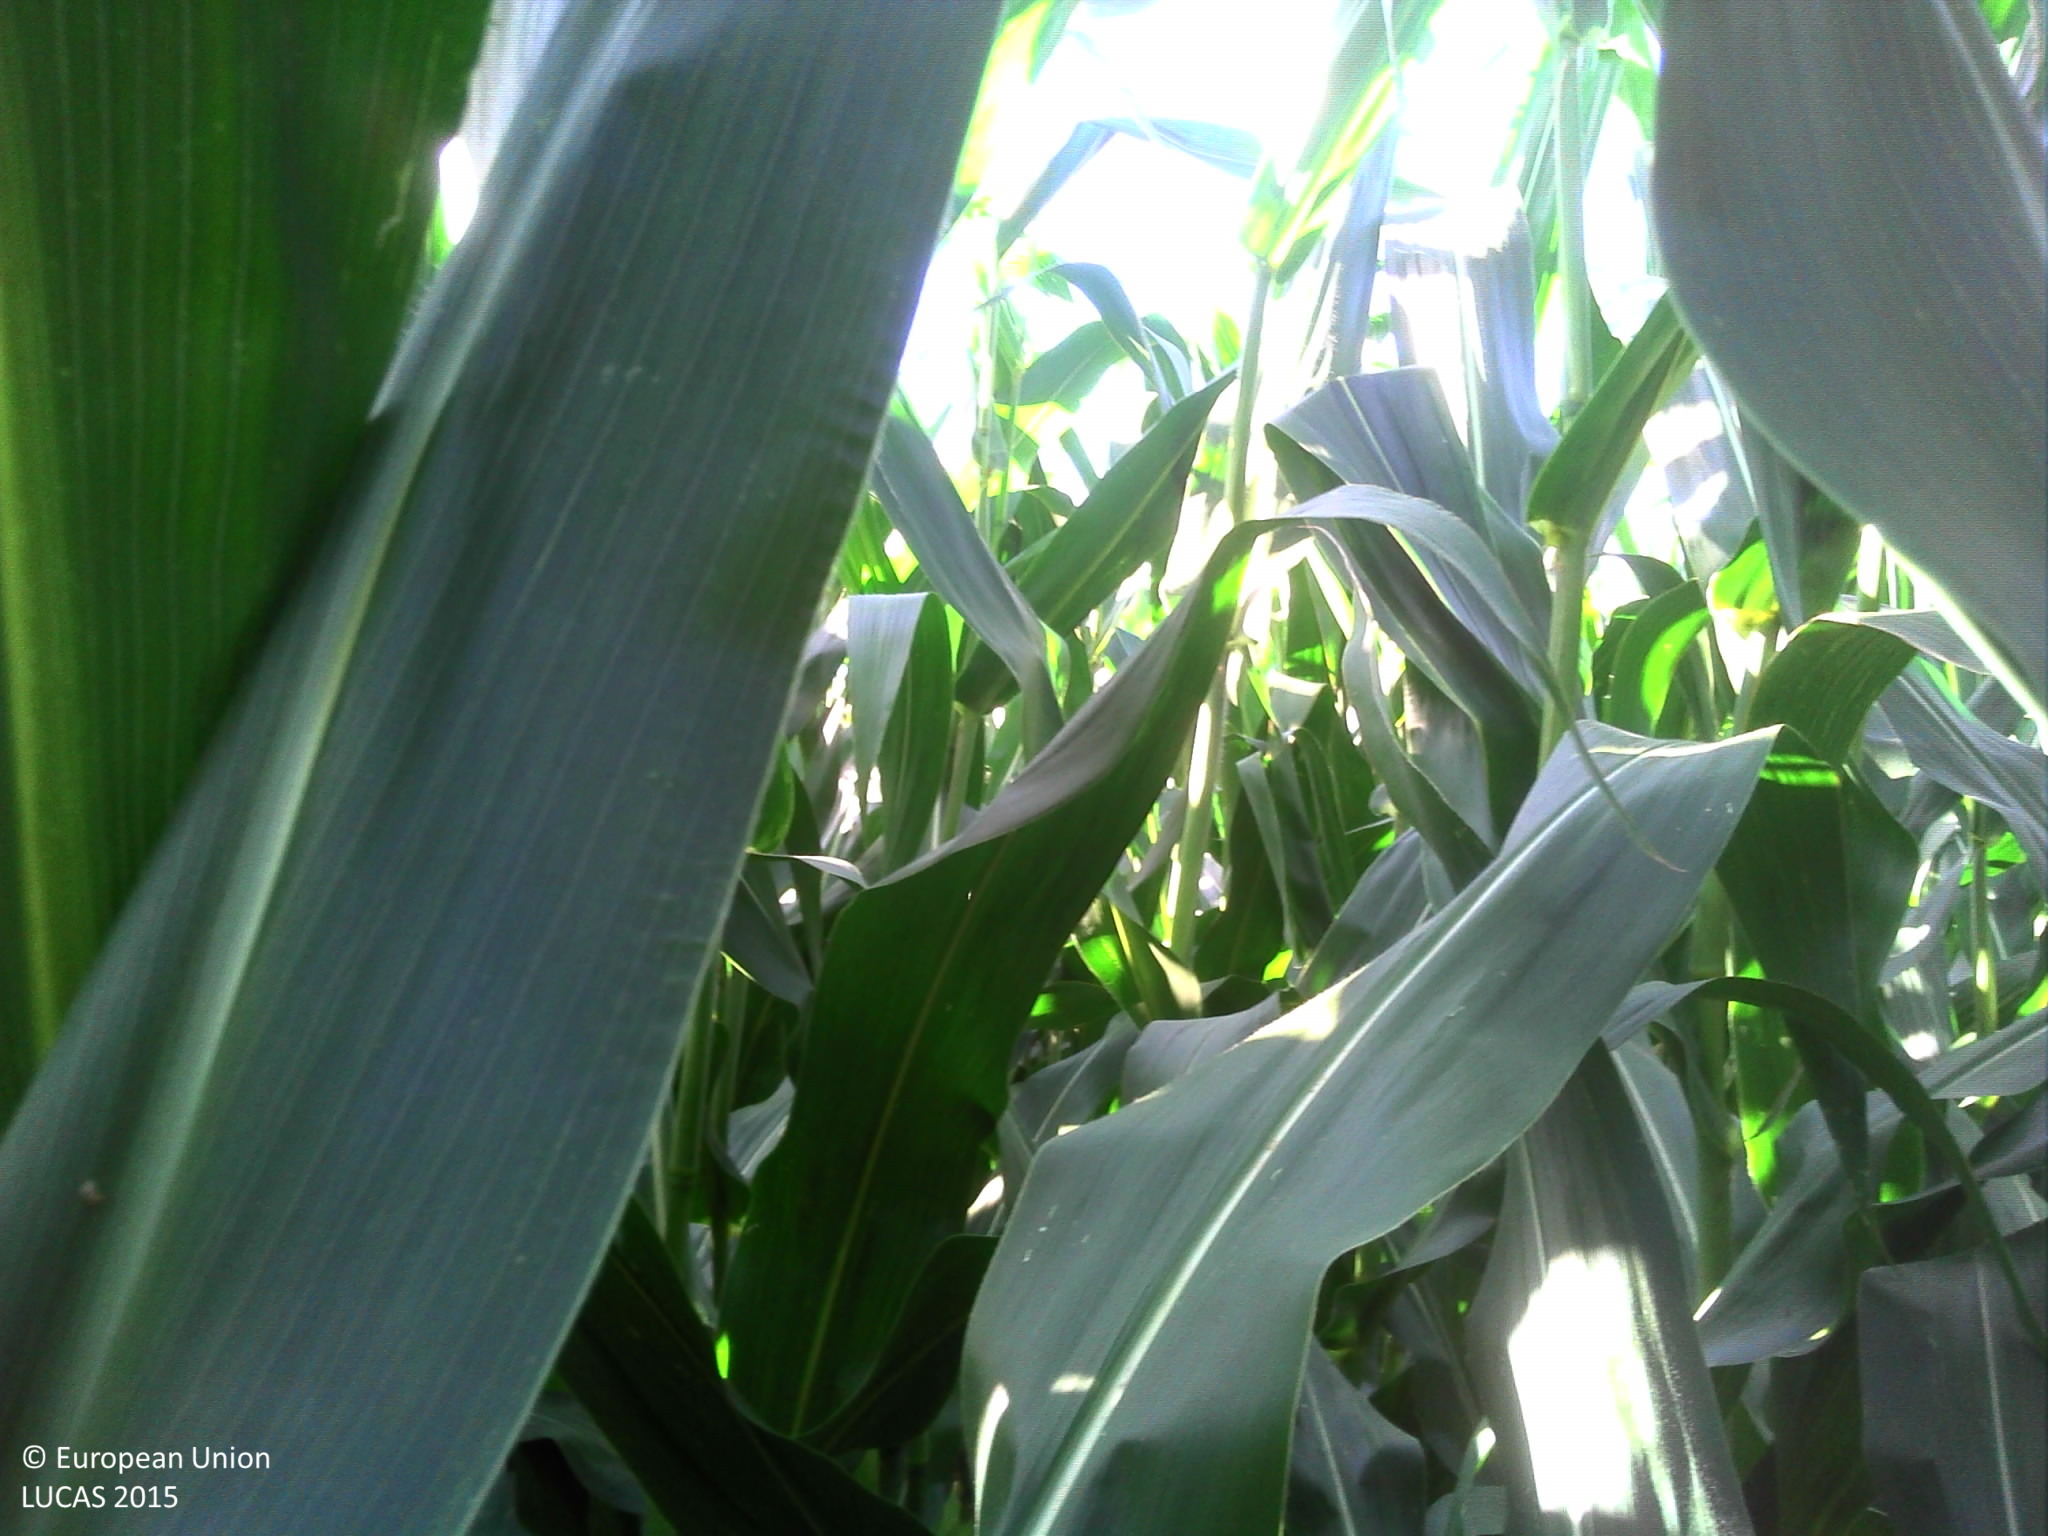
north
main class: Cropland
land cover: Maize
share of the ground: > 75 %
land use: Agriculture (excluding fallow land and kitchen gardens)
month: August
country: FR
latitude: 46.7589
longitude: -1.3889
